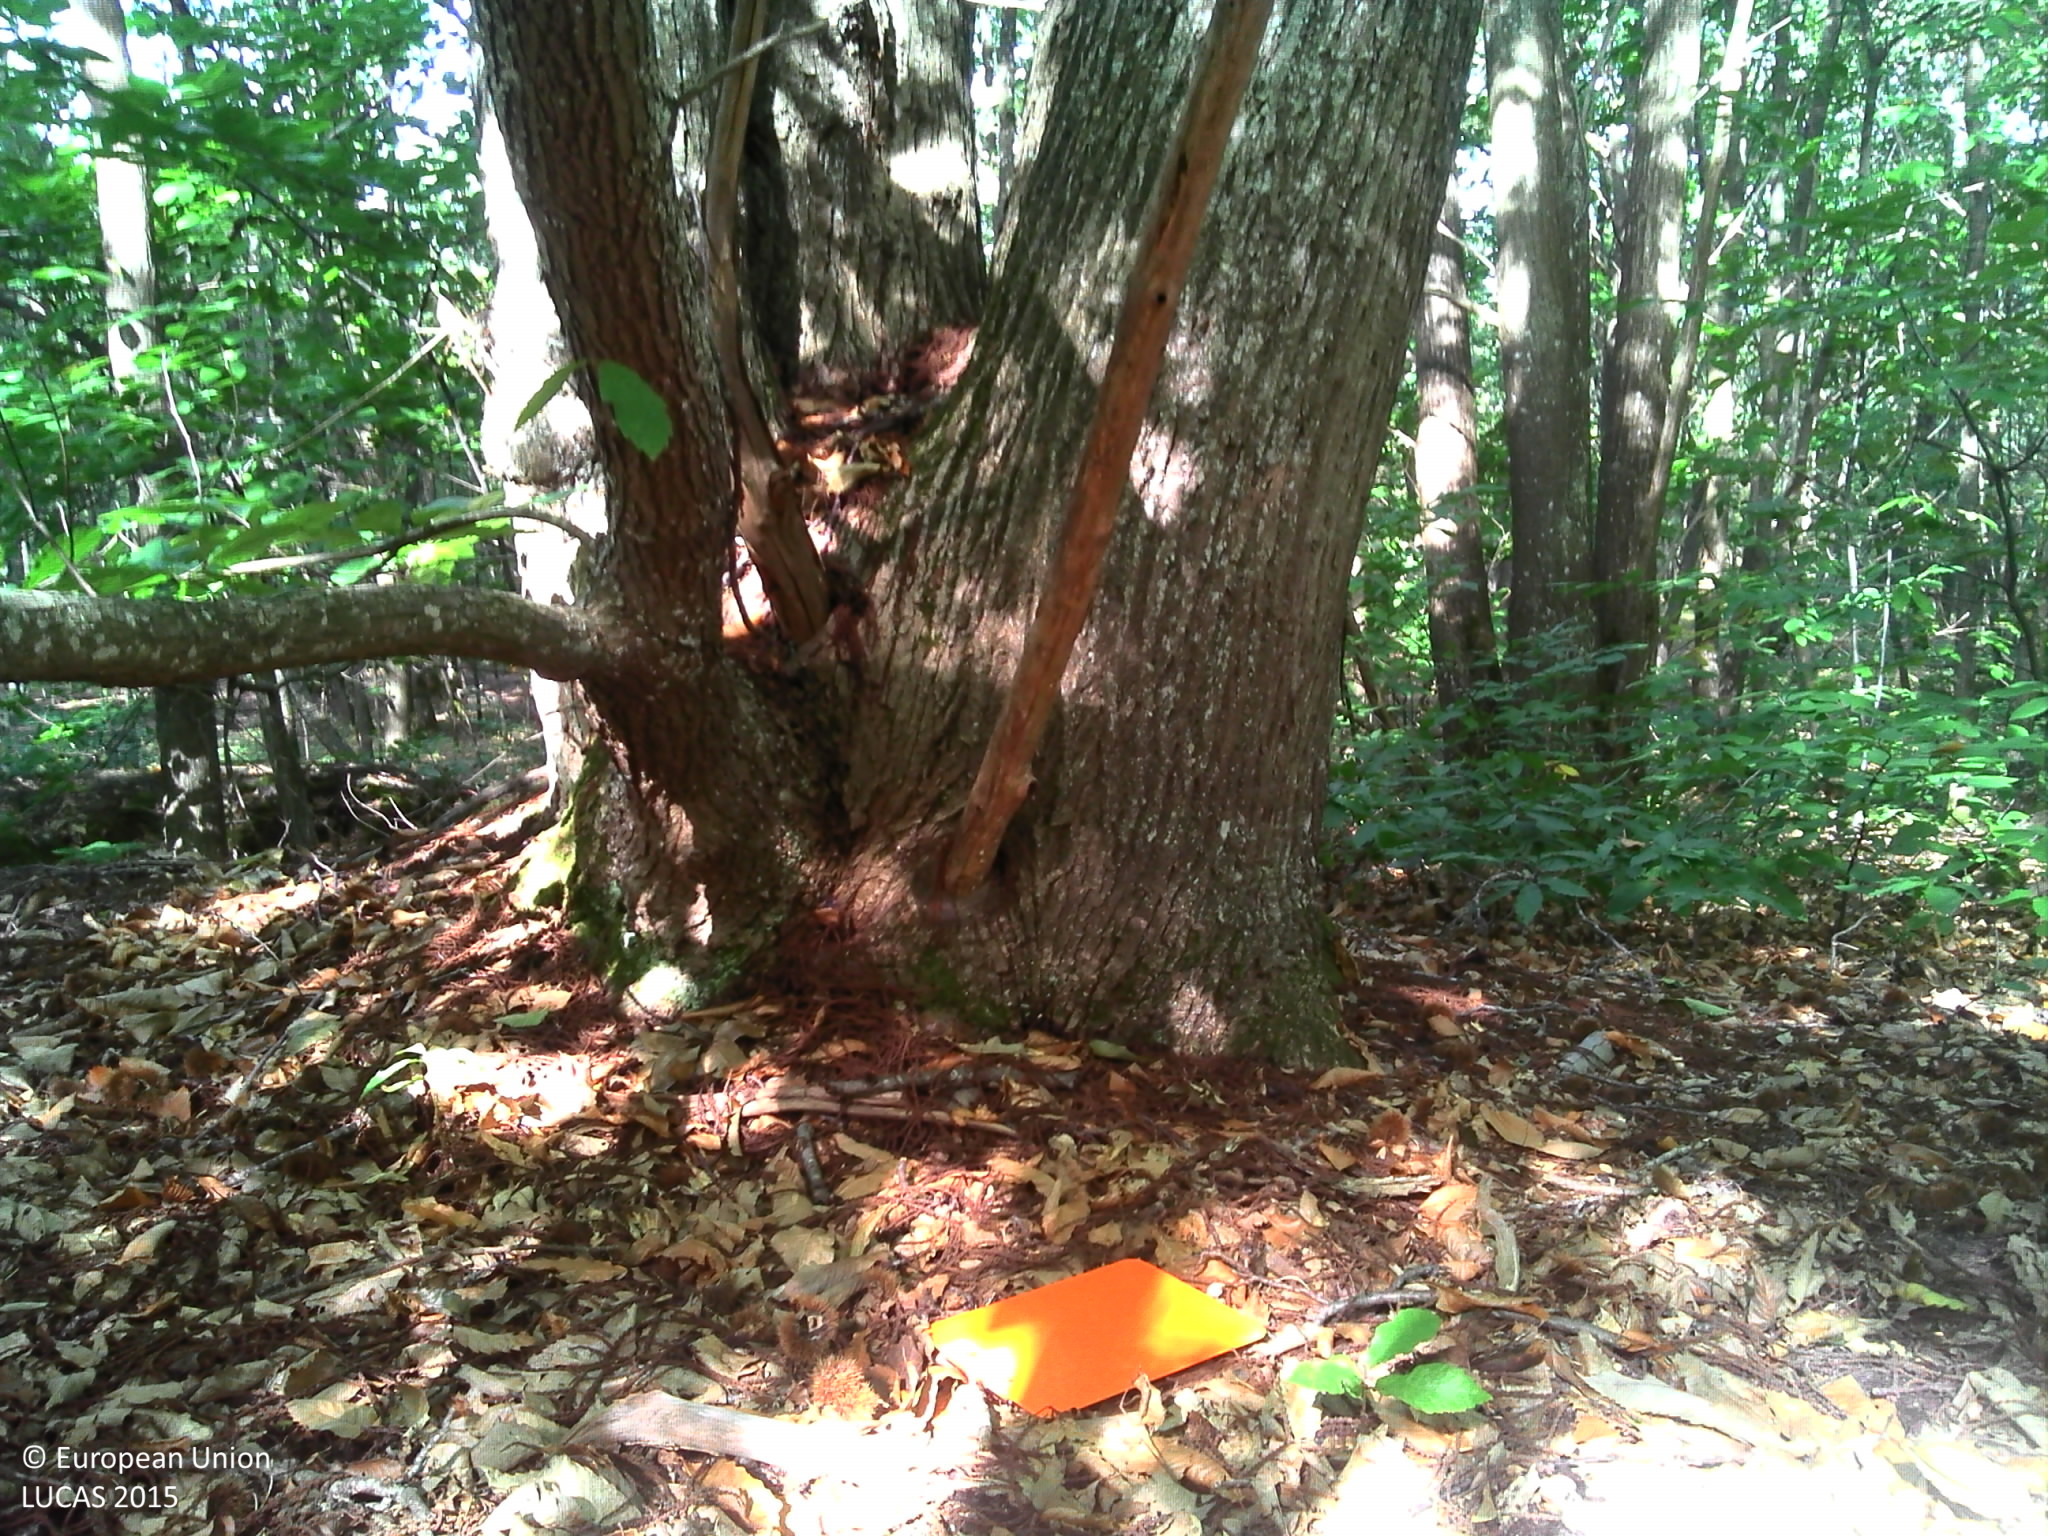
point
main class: Woodland
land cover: Broadleaved woodland
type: acidophilous oak and oak-birch forest
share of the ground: > 75 %
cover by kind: broadleaved forest trees 80 %, shrubs 10 %, herbaceous plants 5 %, lichens and mosses 5 %
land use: Forestry
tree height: > 5 m
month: September
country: FR
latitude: 48.2741
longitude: 2.7556
